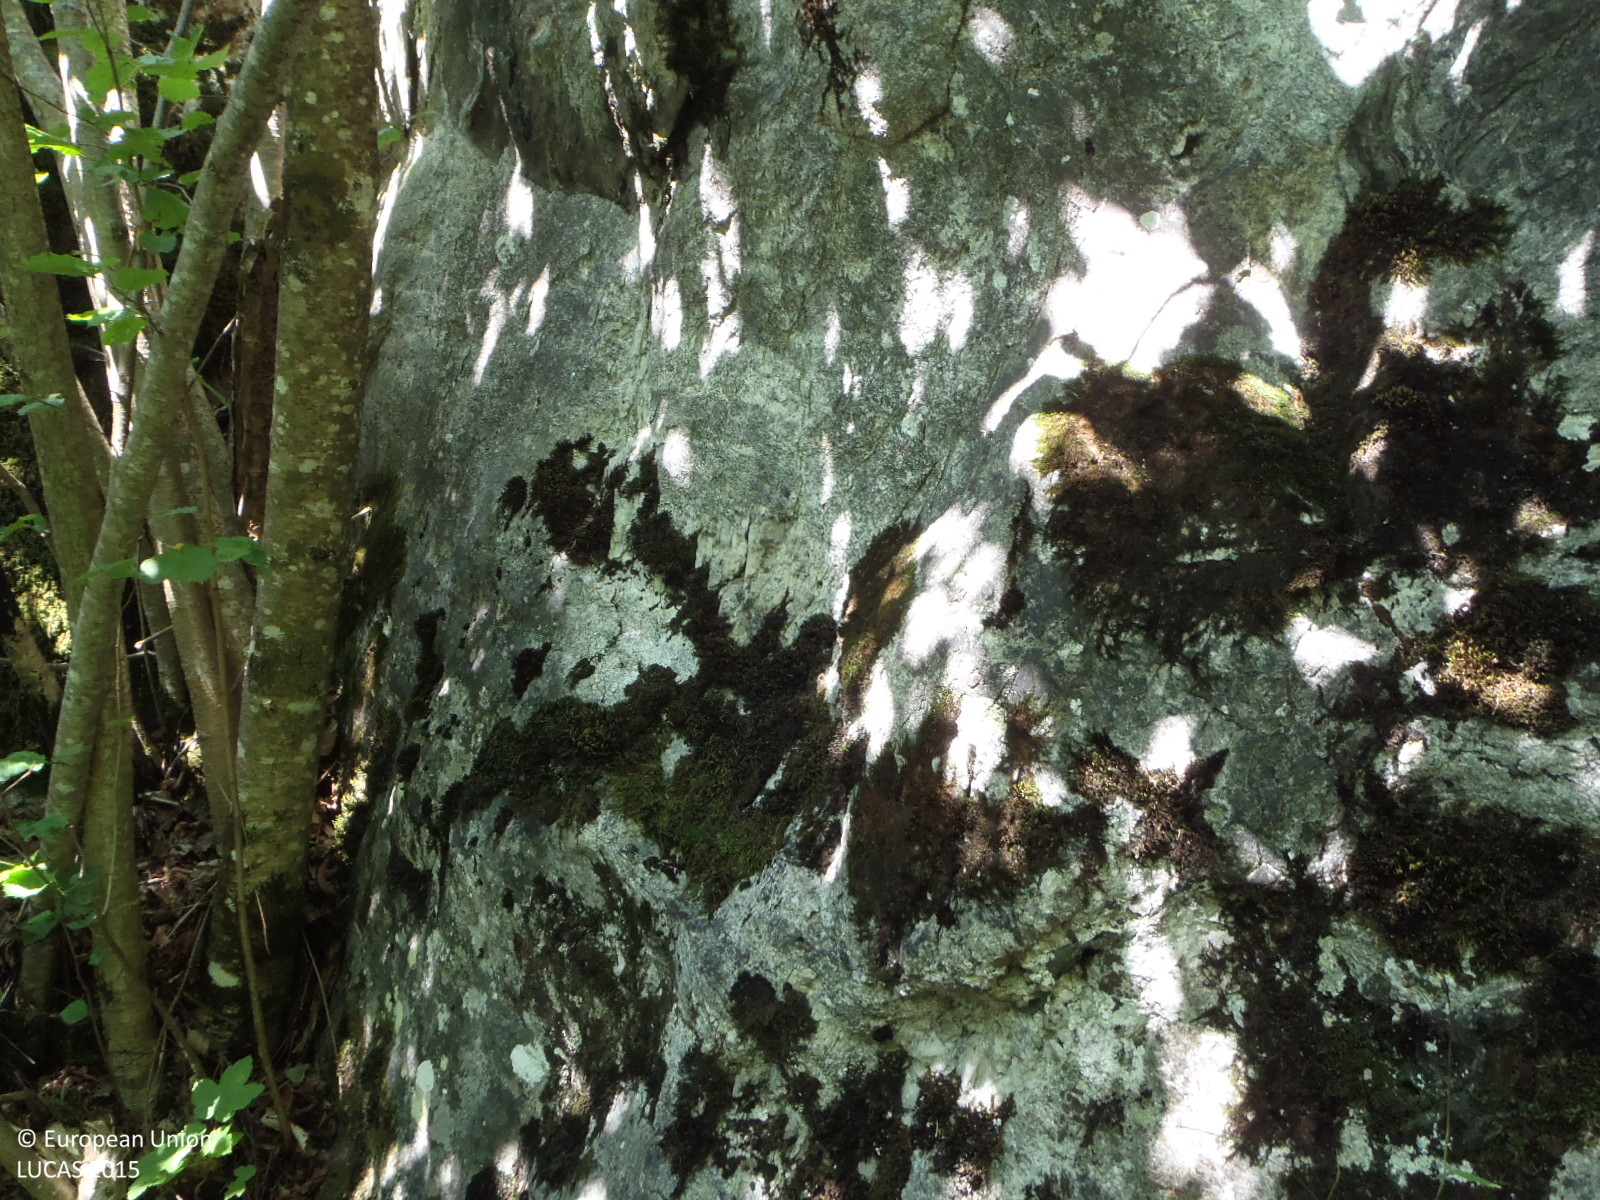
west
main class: Woodland
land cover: Broadleaved woodland
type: mountainous beech forest
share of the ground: > 75 %
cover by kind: broadleaved forest trees 75 %, coniferous forest trees 15 %, herbaceous plants 5 %, consolidated bare surface 5 %
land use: Forestry
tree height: > 5 m
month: July
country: AT
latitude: 47.0930
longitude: 11.7768
